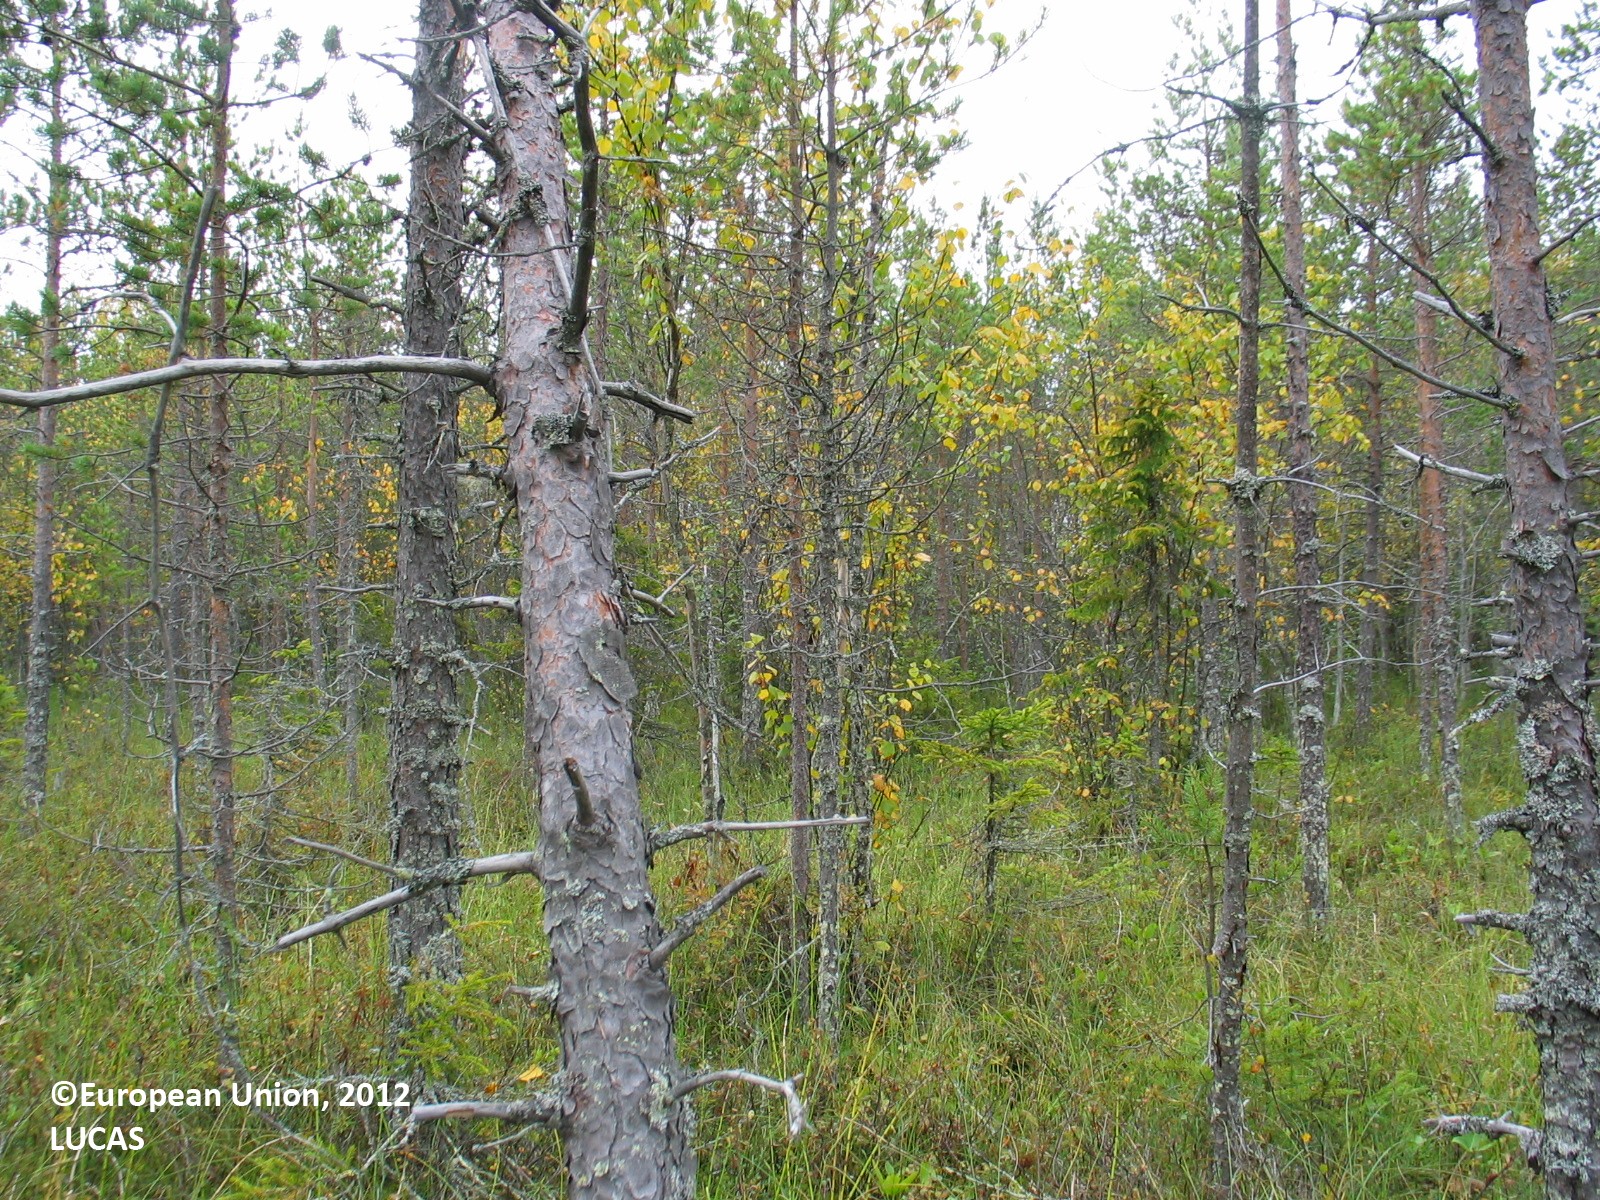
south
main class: Woodland
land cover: Pine dominated coniferous woodland
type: mire and swamp forests
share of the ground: 25 - 50 %
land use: Forestry
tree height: > 5 m
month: September
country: FI
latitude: 65.6053
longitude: 25.1492
